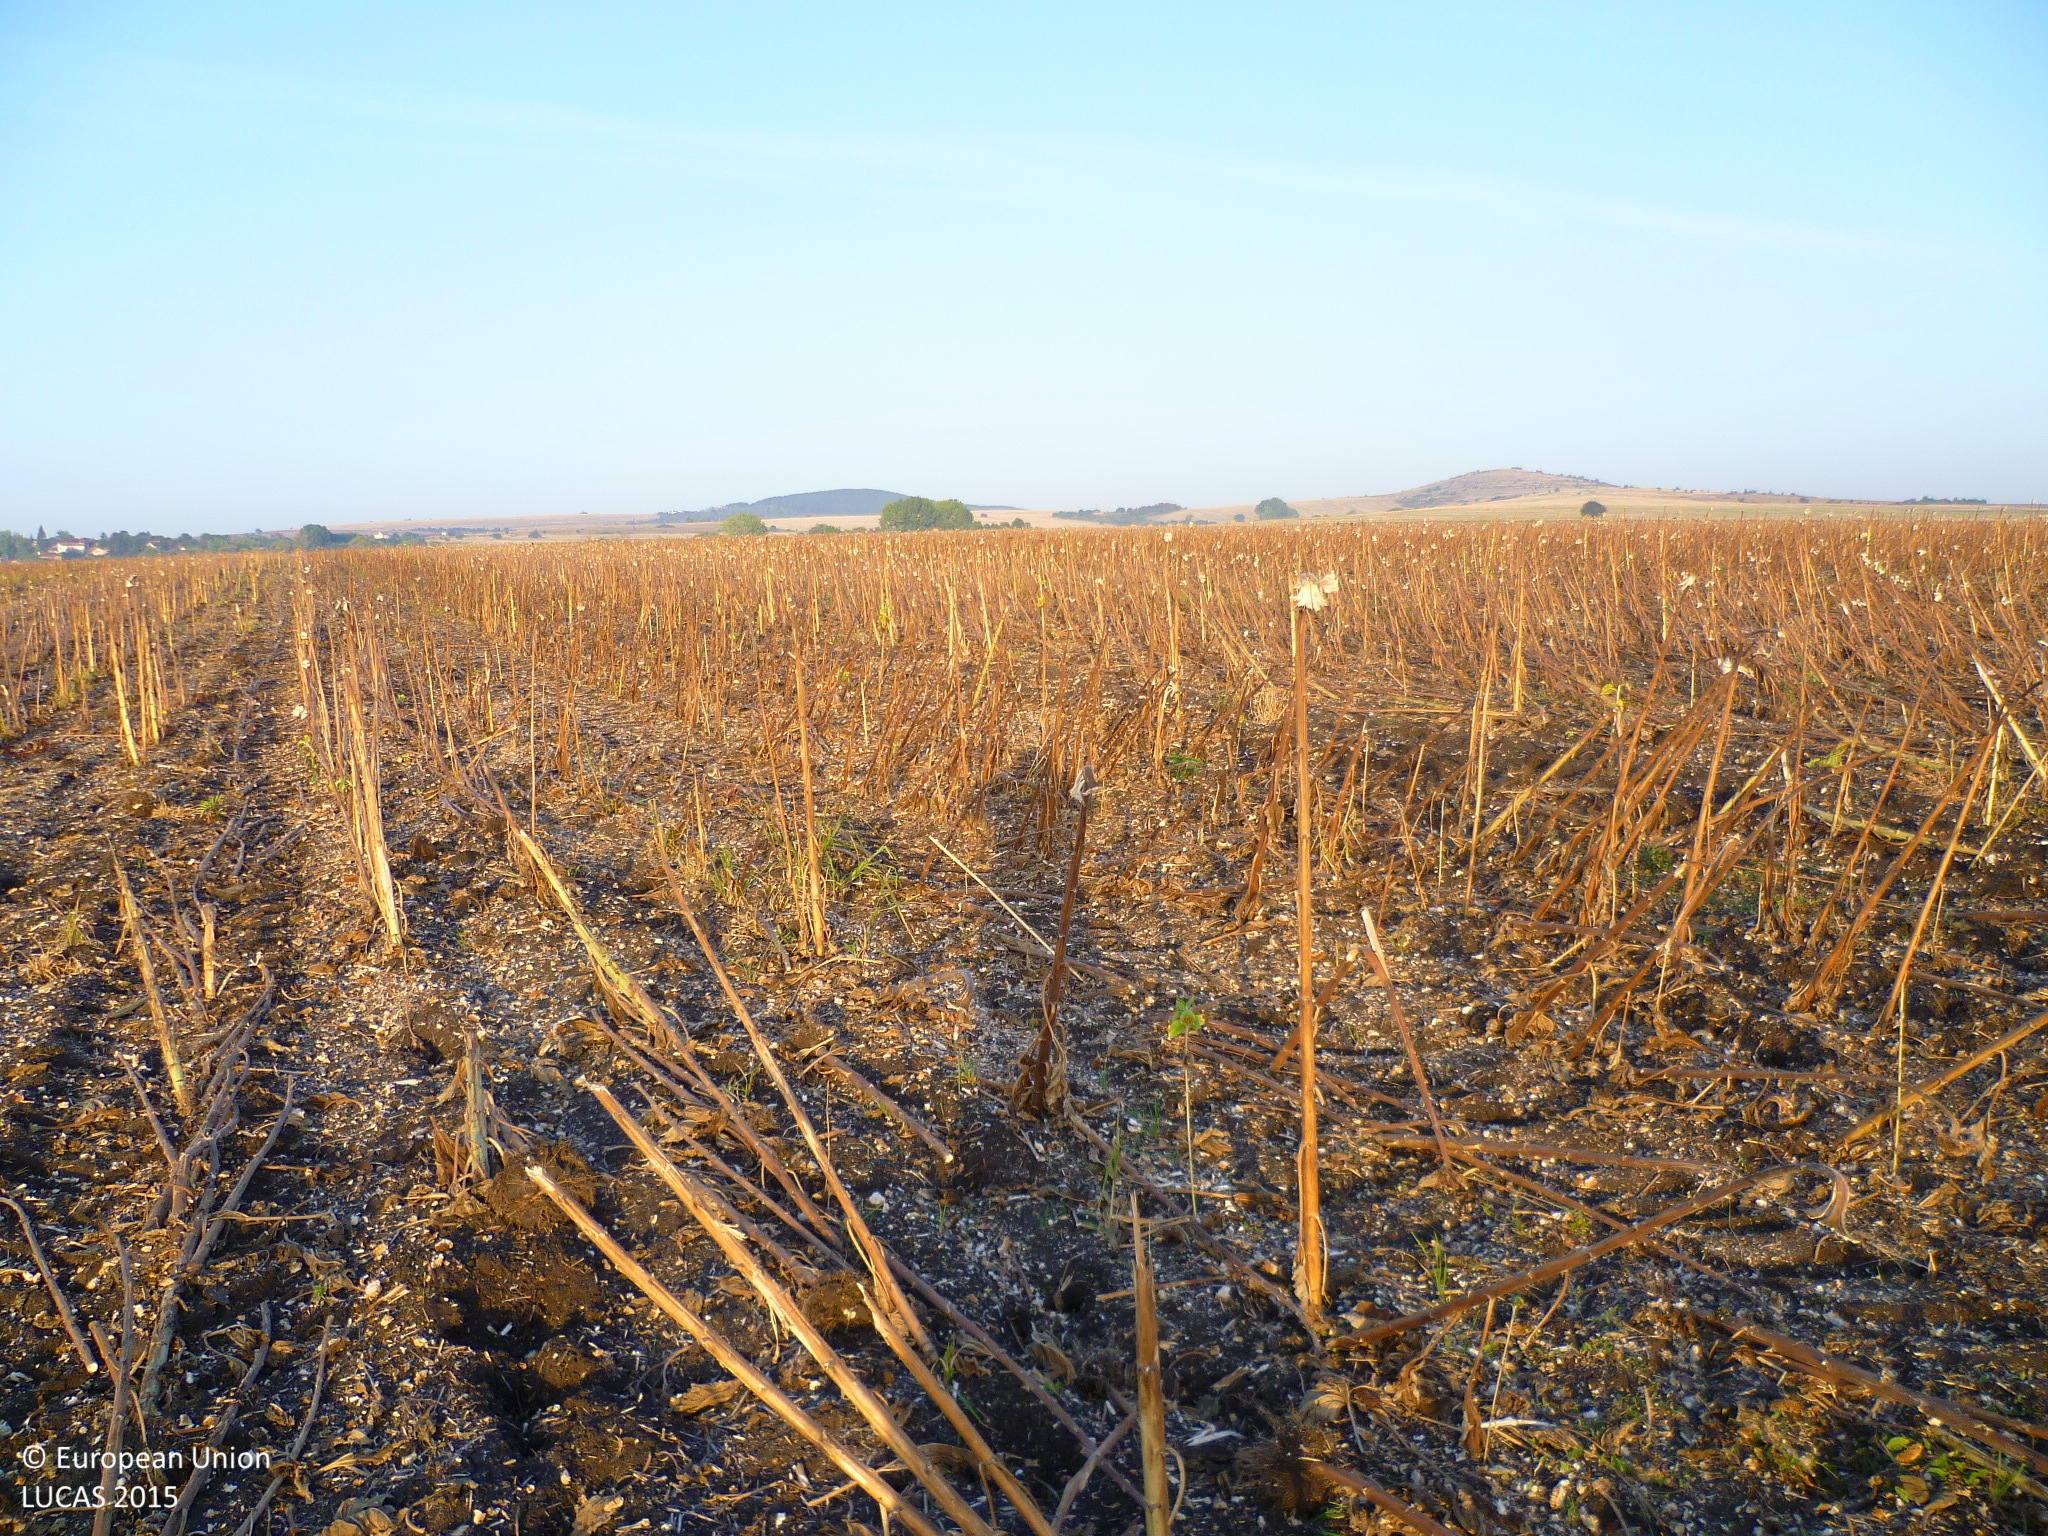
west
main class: Cropland
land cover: Sunflower
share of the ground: 25 - 50 %
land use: Agriculture (excluding fallow land and kitchen gardens)
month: September
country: BG
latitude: 42.7617
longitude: 23.1440
